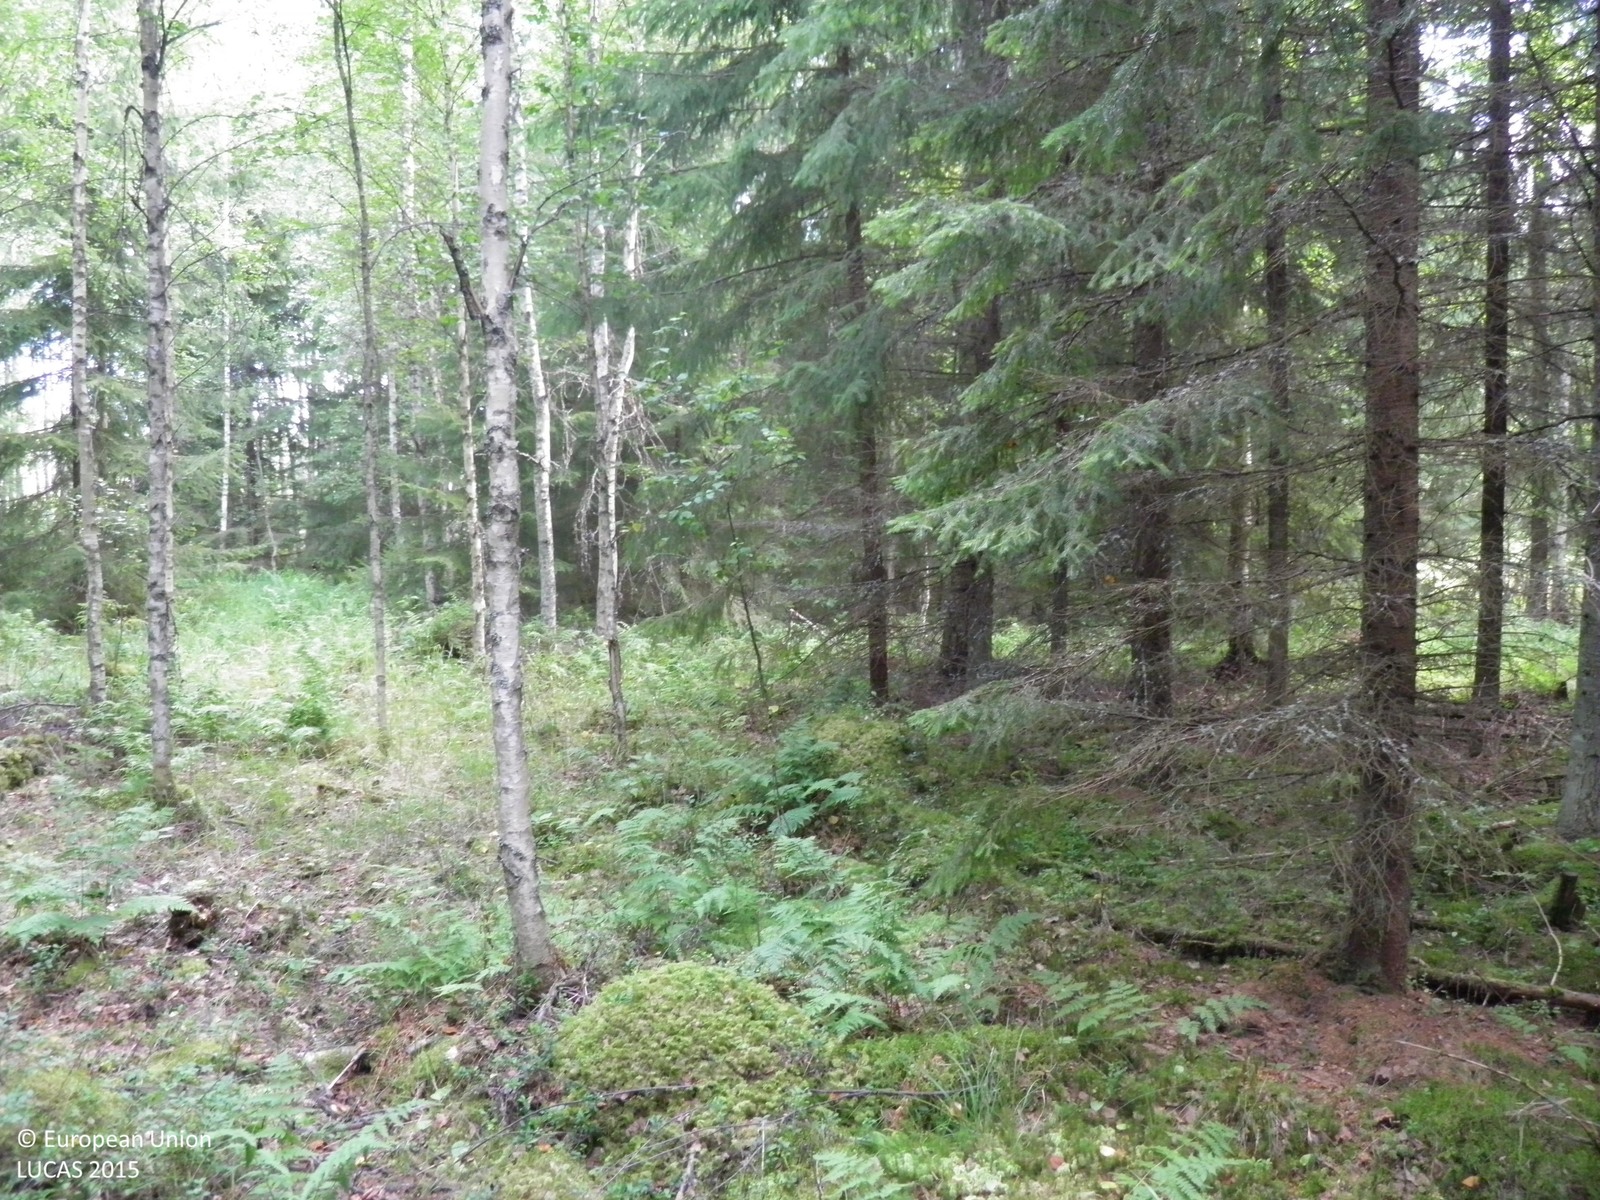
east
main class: Woodland
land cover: Spruce dominated mixed woodland
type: hemiboreal forest and nemoral coniferous forest and mixed broadleaved-coniferous forest
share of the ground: 50 - 75 %
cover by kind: coniferous forest trees 40 %, broadleaved forest trees 30 %, shrubs 15 %, lichens and mosses 15 %
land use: Forestry
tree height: > 5 m
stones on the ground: < 10 %
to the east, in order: Spruce dominated mixed woodland; Ditches and canals; Spruce dominated mixed woodland; Tracks; Spruce dominated mixed woodland; Ditches and canals; Grass margins; Common wheat; Grass margins; Ditches and canals; Paved roads, cycling and walking lanes
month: August
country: FI
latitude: 60.9158
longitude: 22.7408
